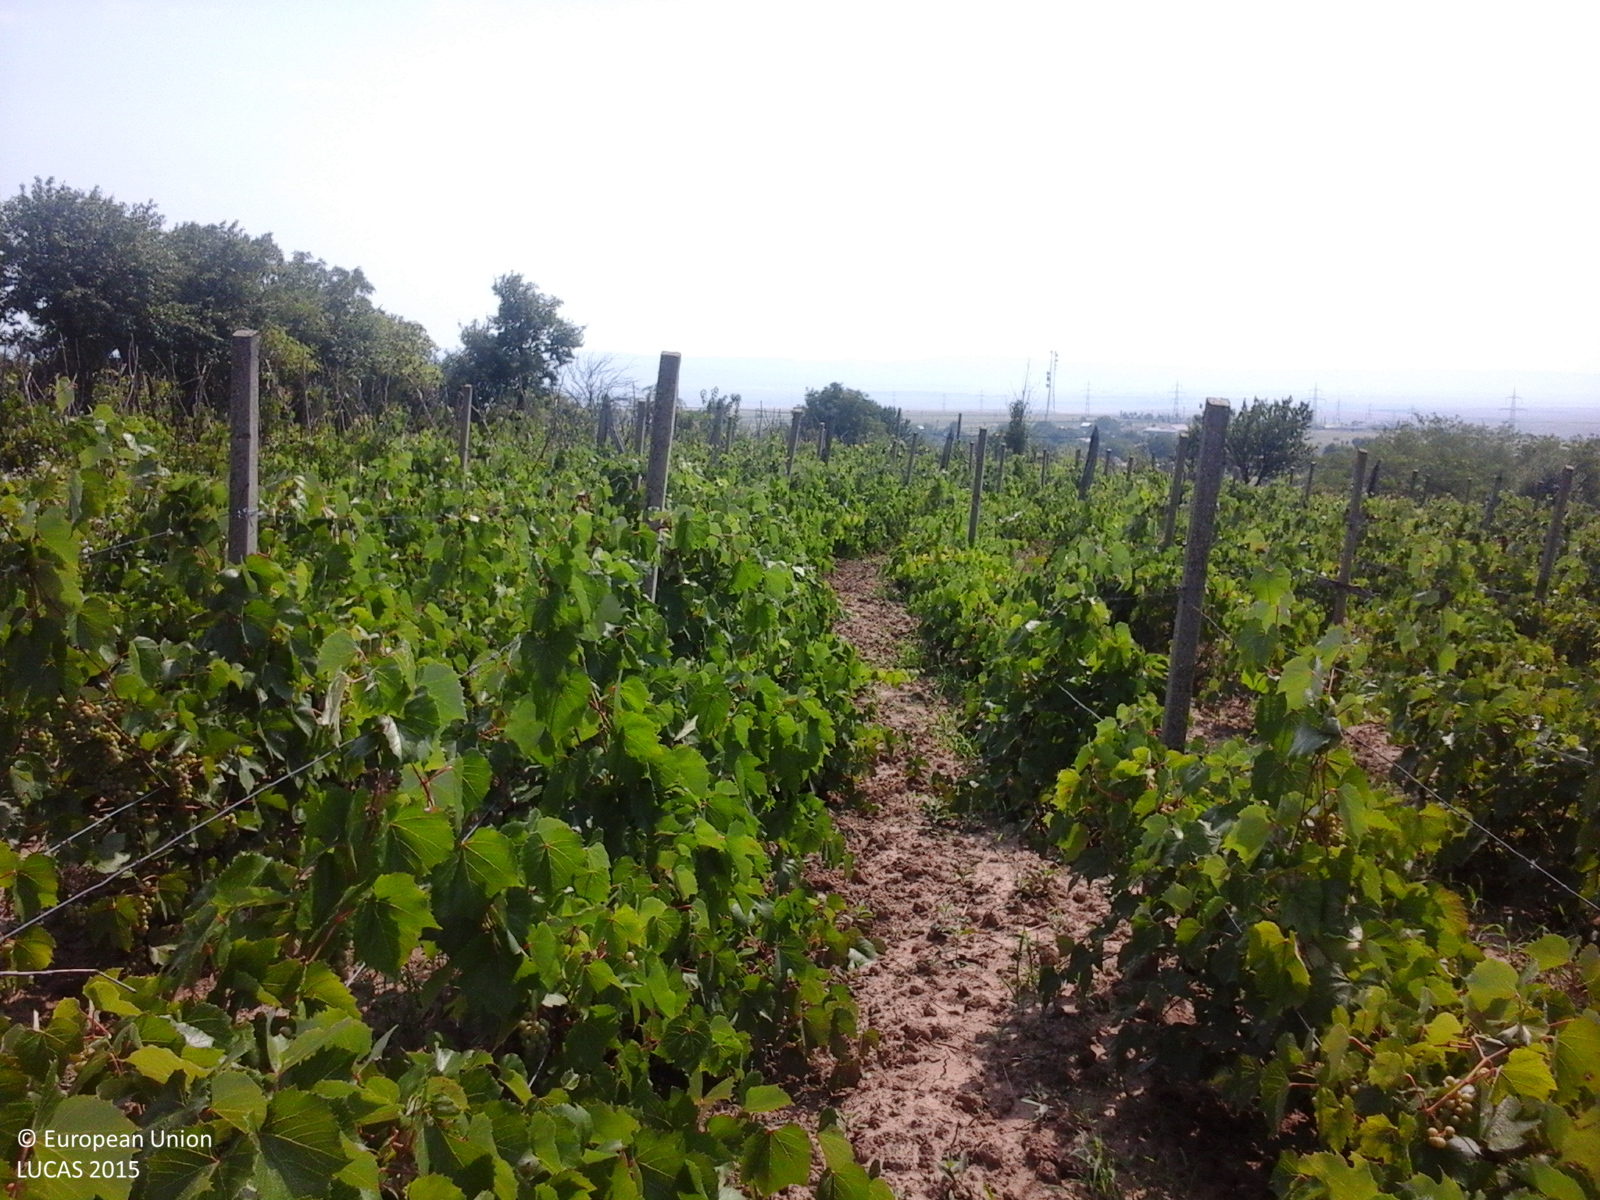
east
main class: Cropland
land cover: Vineyards
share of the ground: > 75 %
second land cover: Other bare soil
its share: > 75 %
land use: Agriculture (excluding fallow land and kitchen gardens)
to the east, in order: Vineyards; Other bare soil; Grassland with sparse tree/shrub cover; Vineyards; Abandoned hedges; Vineyards; Single bushes/trees; Vineyards; Spontaneously vegetated surfaces; Grassland with sparse tree/shrub cover; Tracks; Vineyards; Other leguminous and mixtures for fodder
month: August
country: RO
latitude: 46.1827
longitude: 27.0533
